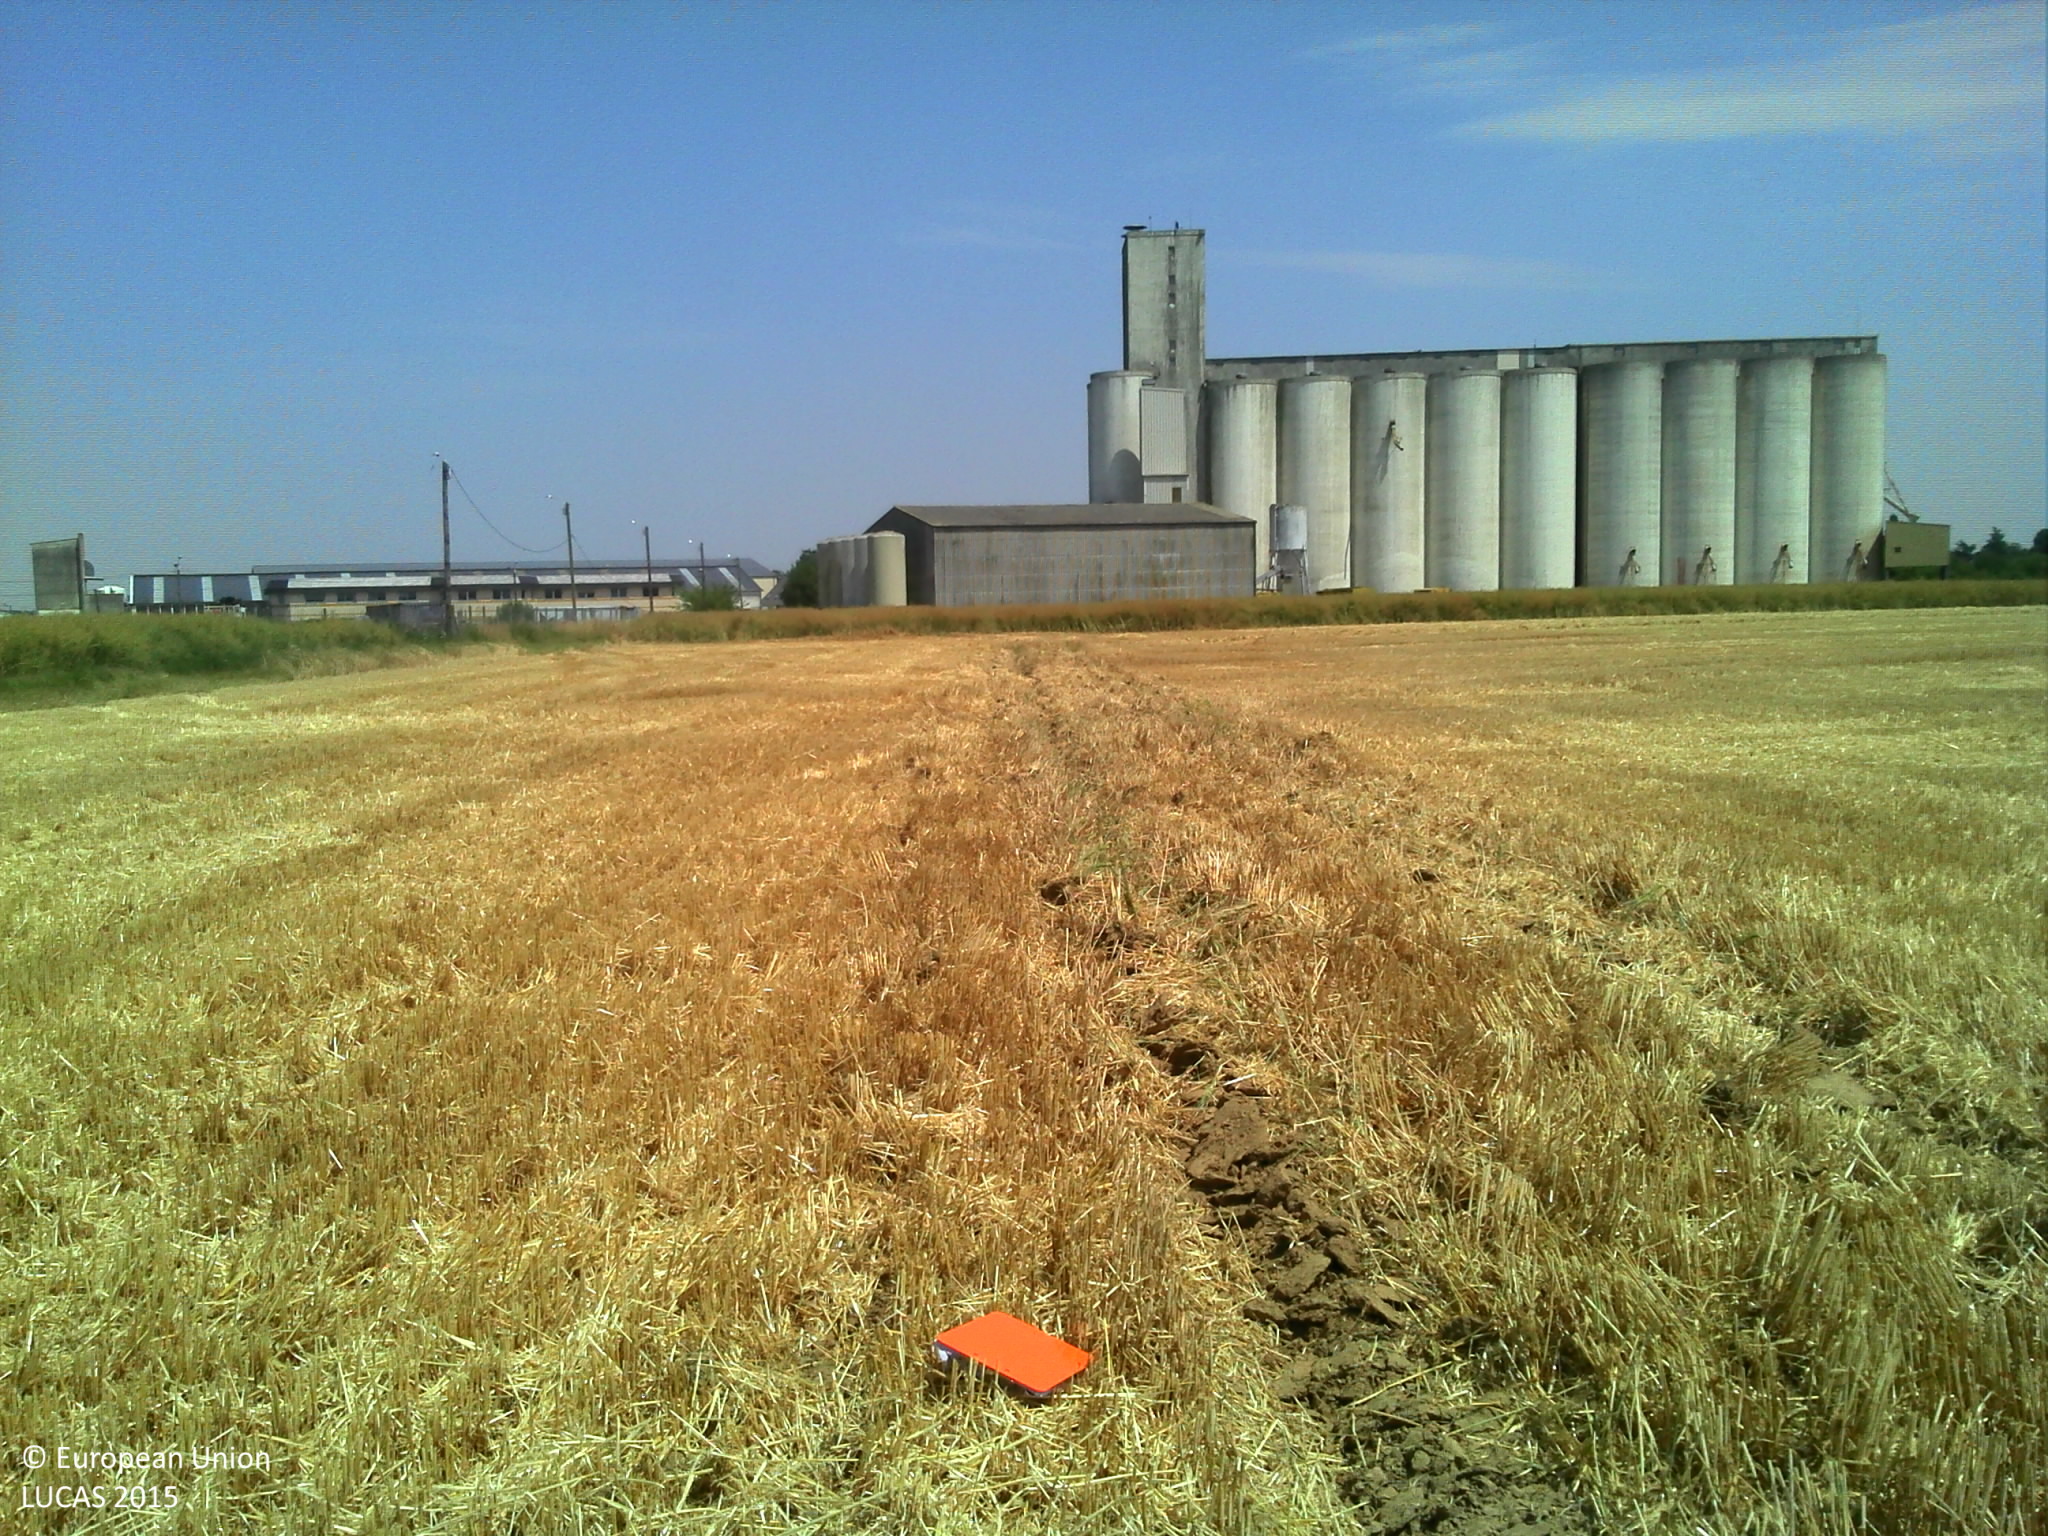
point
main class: Cropland
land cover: Barley
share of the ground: > 75 %
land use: Agriculture (excluding fallow land and kitchen gardens)
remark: Harvested field
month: July
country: FR
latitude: 48.9076
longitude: 1.2624
